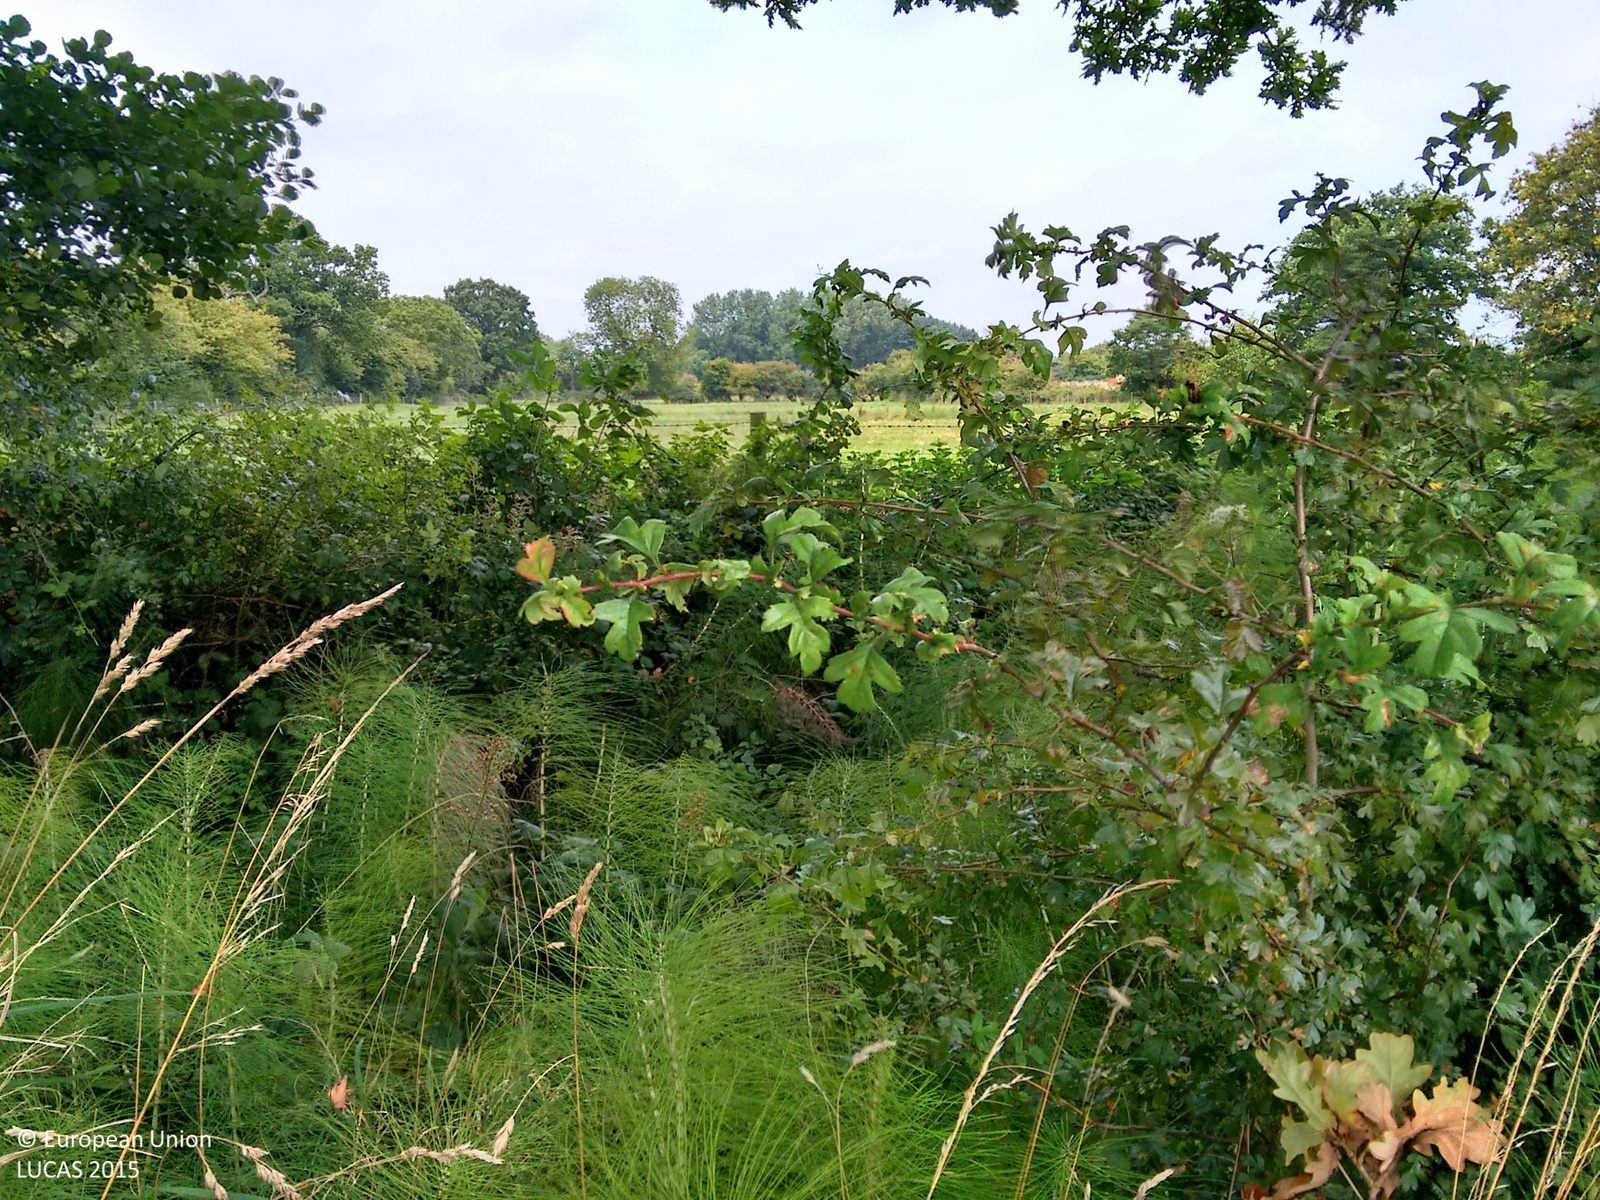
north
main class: Woodland
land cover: Broadleaved woodland
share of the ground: > 75 %
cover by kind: broadleaved forest trees 100 %
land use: Agriculture (excluding fallow land and kitchen gardens)
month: September
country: GB
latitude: 52.8465
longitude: 0.9642
